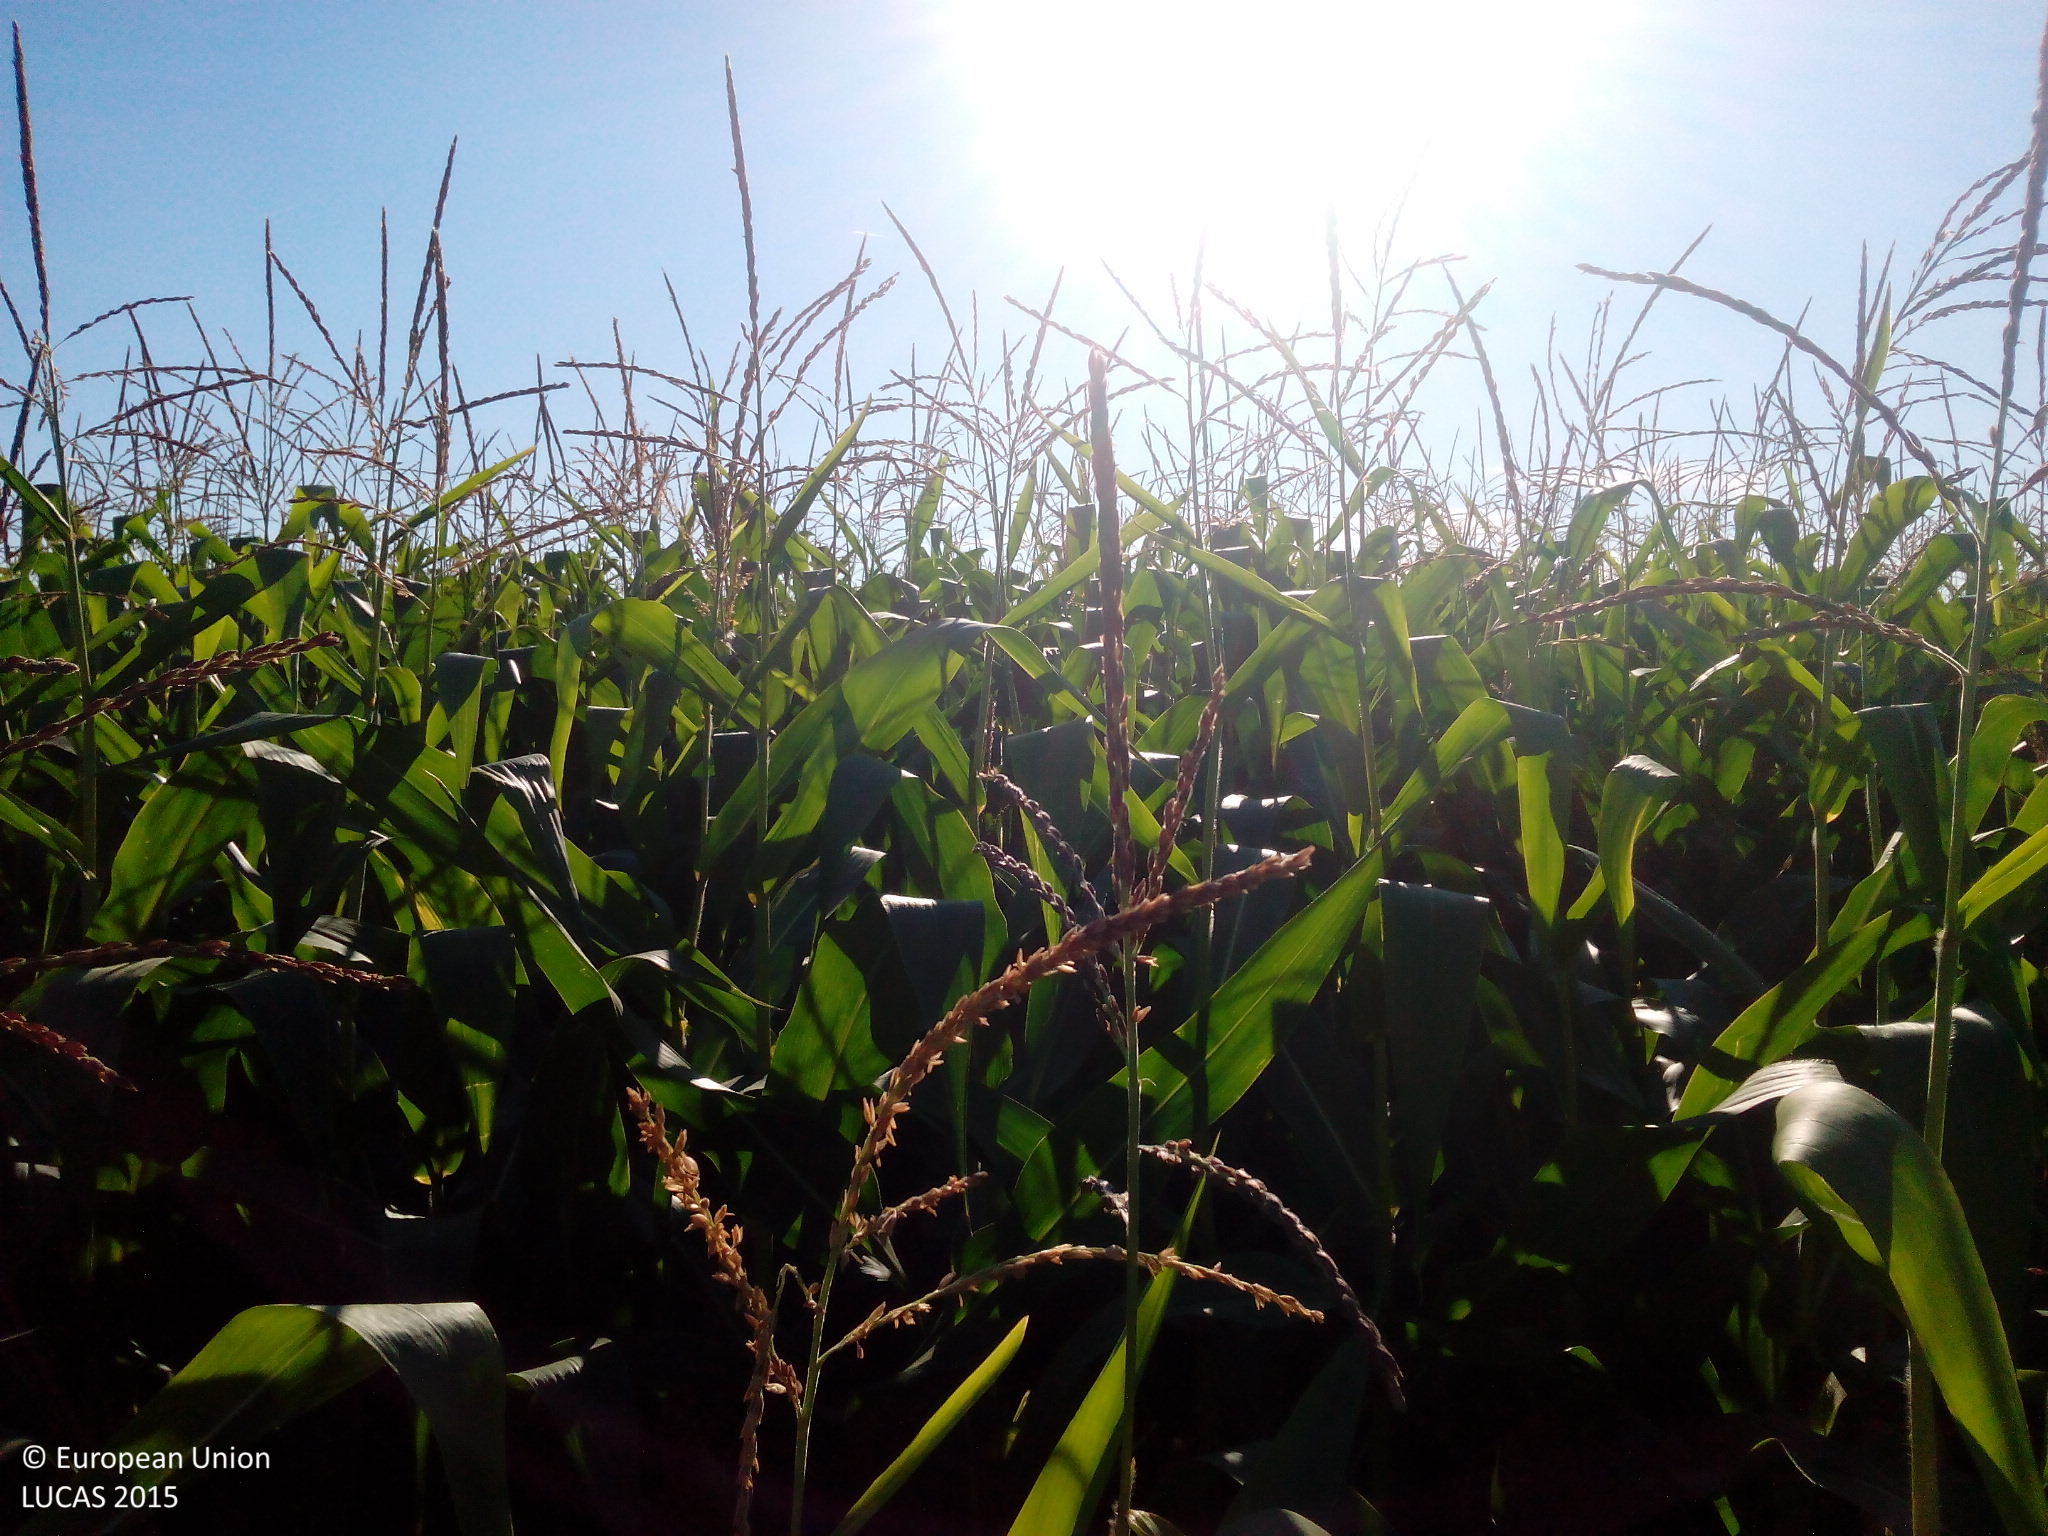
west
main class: Cropland
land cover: Maize
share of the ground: > 75 %
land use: Agriculture (excluding fallow land and kitchen gardens)
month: August
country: DE
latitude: 49.3836
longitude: 8.5541
